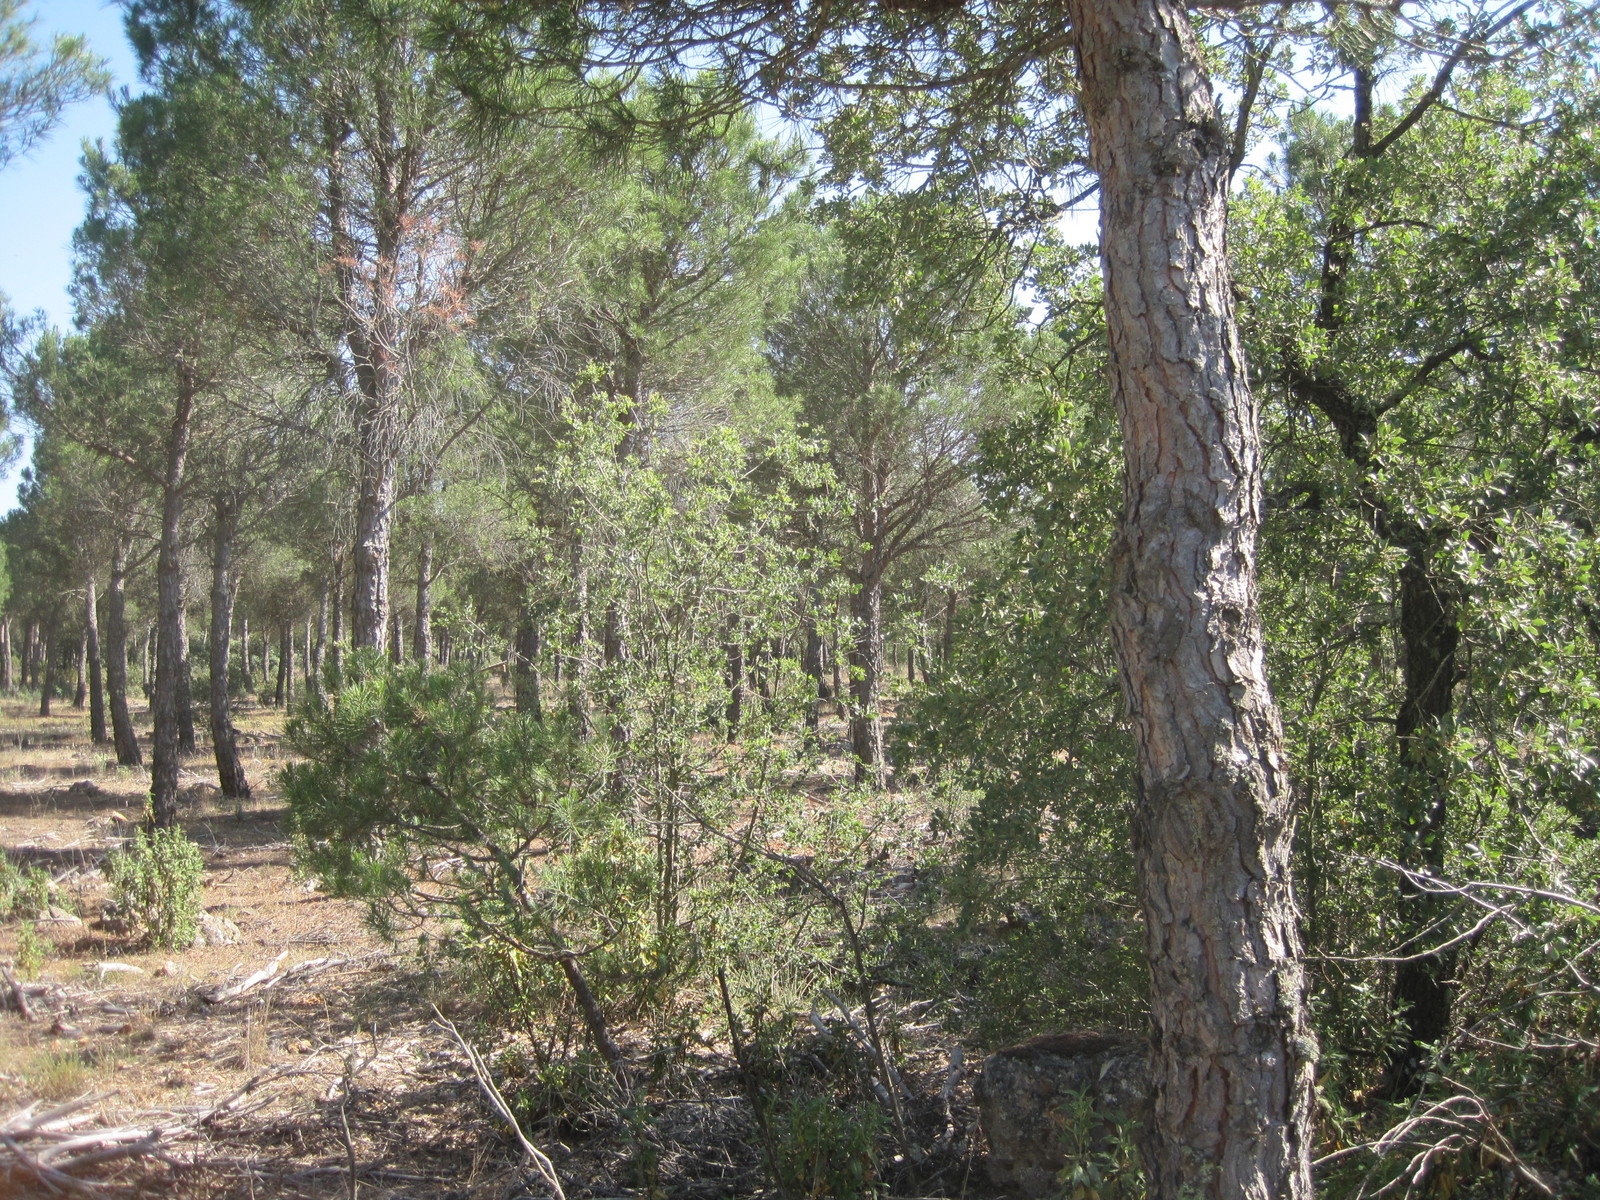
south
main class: Woodland
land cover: Pine dominated mixed woodland
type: coniferous forest of the mediterranean region
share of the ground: > 75 %
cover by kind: coniferous forest trees 50 %, broadleaved forest trees 30 %, herbaceous plants 20 %
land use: Forestry
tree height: > 5 m
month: July
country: ES
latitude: 41.8843
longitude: -4.7138
